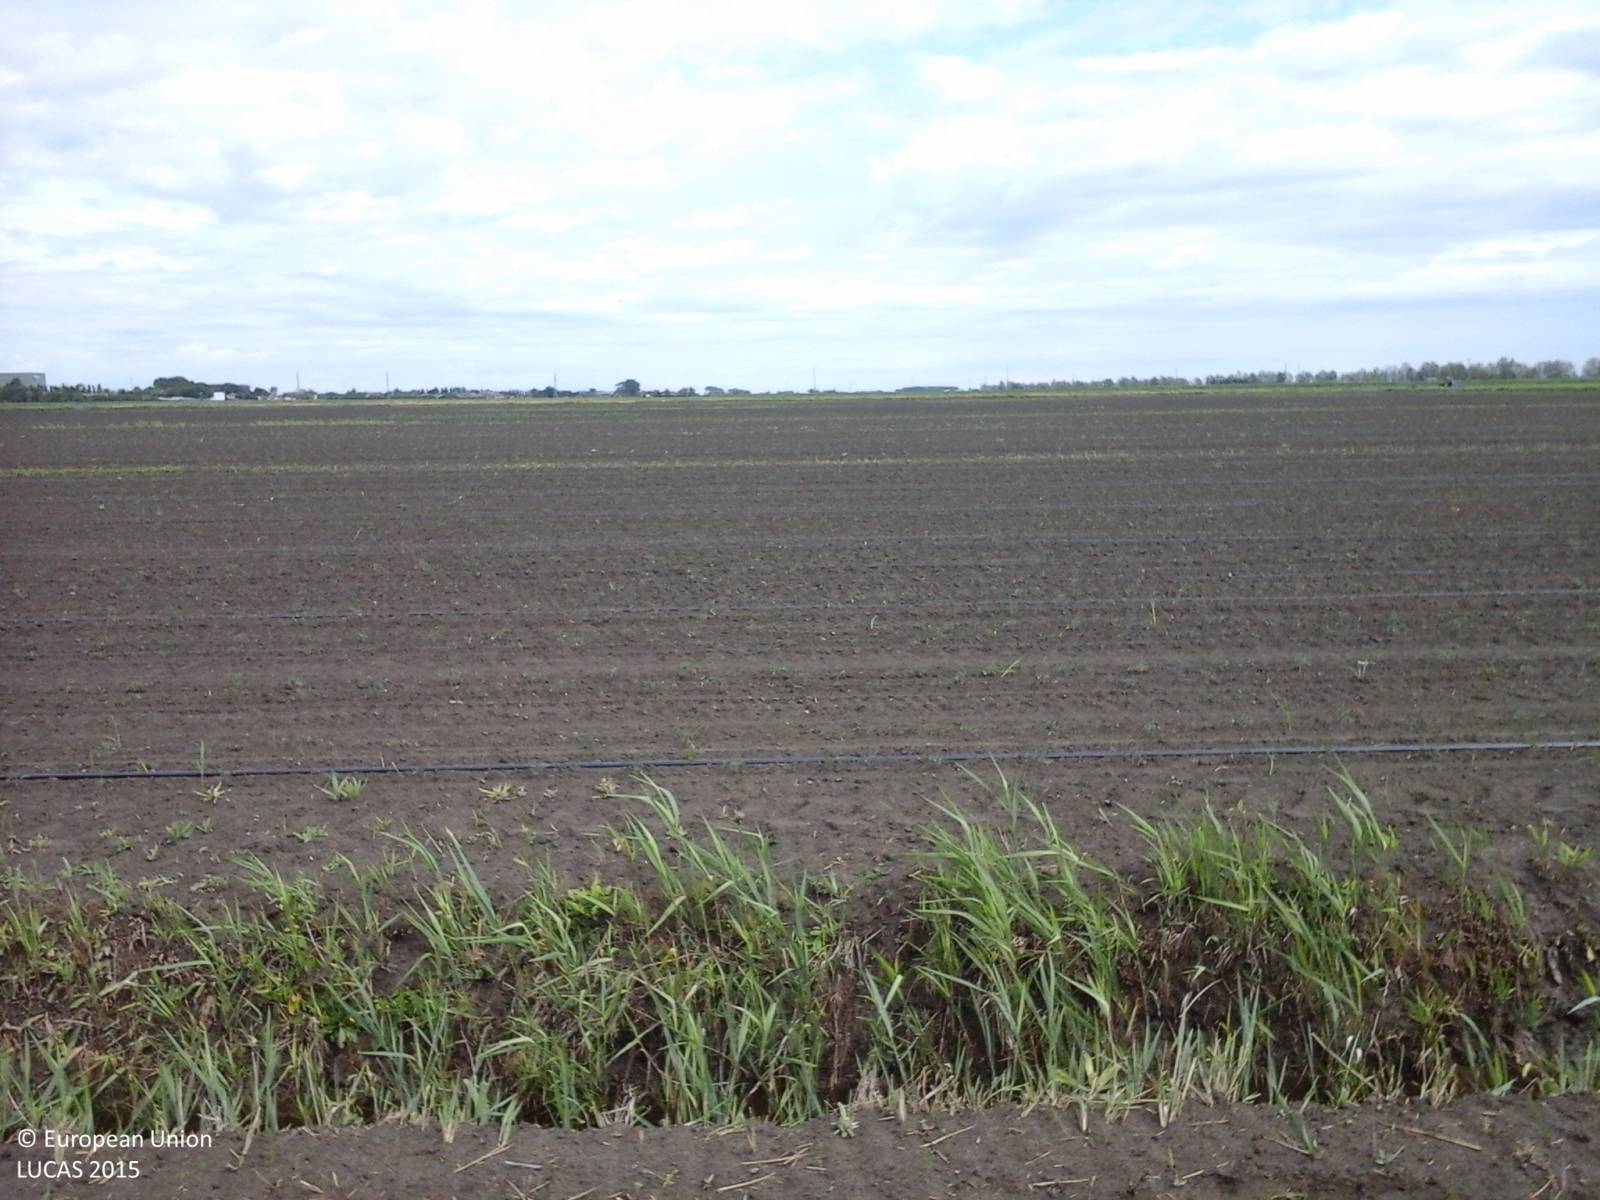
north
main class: Cropland
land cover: Tomatoes
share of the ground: < 10 %
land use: Agriculture (excluding fallow land and kitchen gardens)
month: April
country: IT
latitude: 44.8327
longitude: 12.1841
